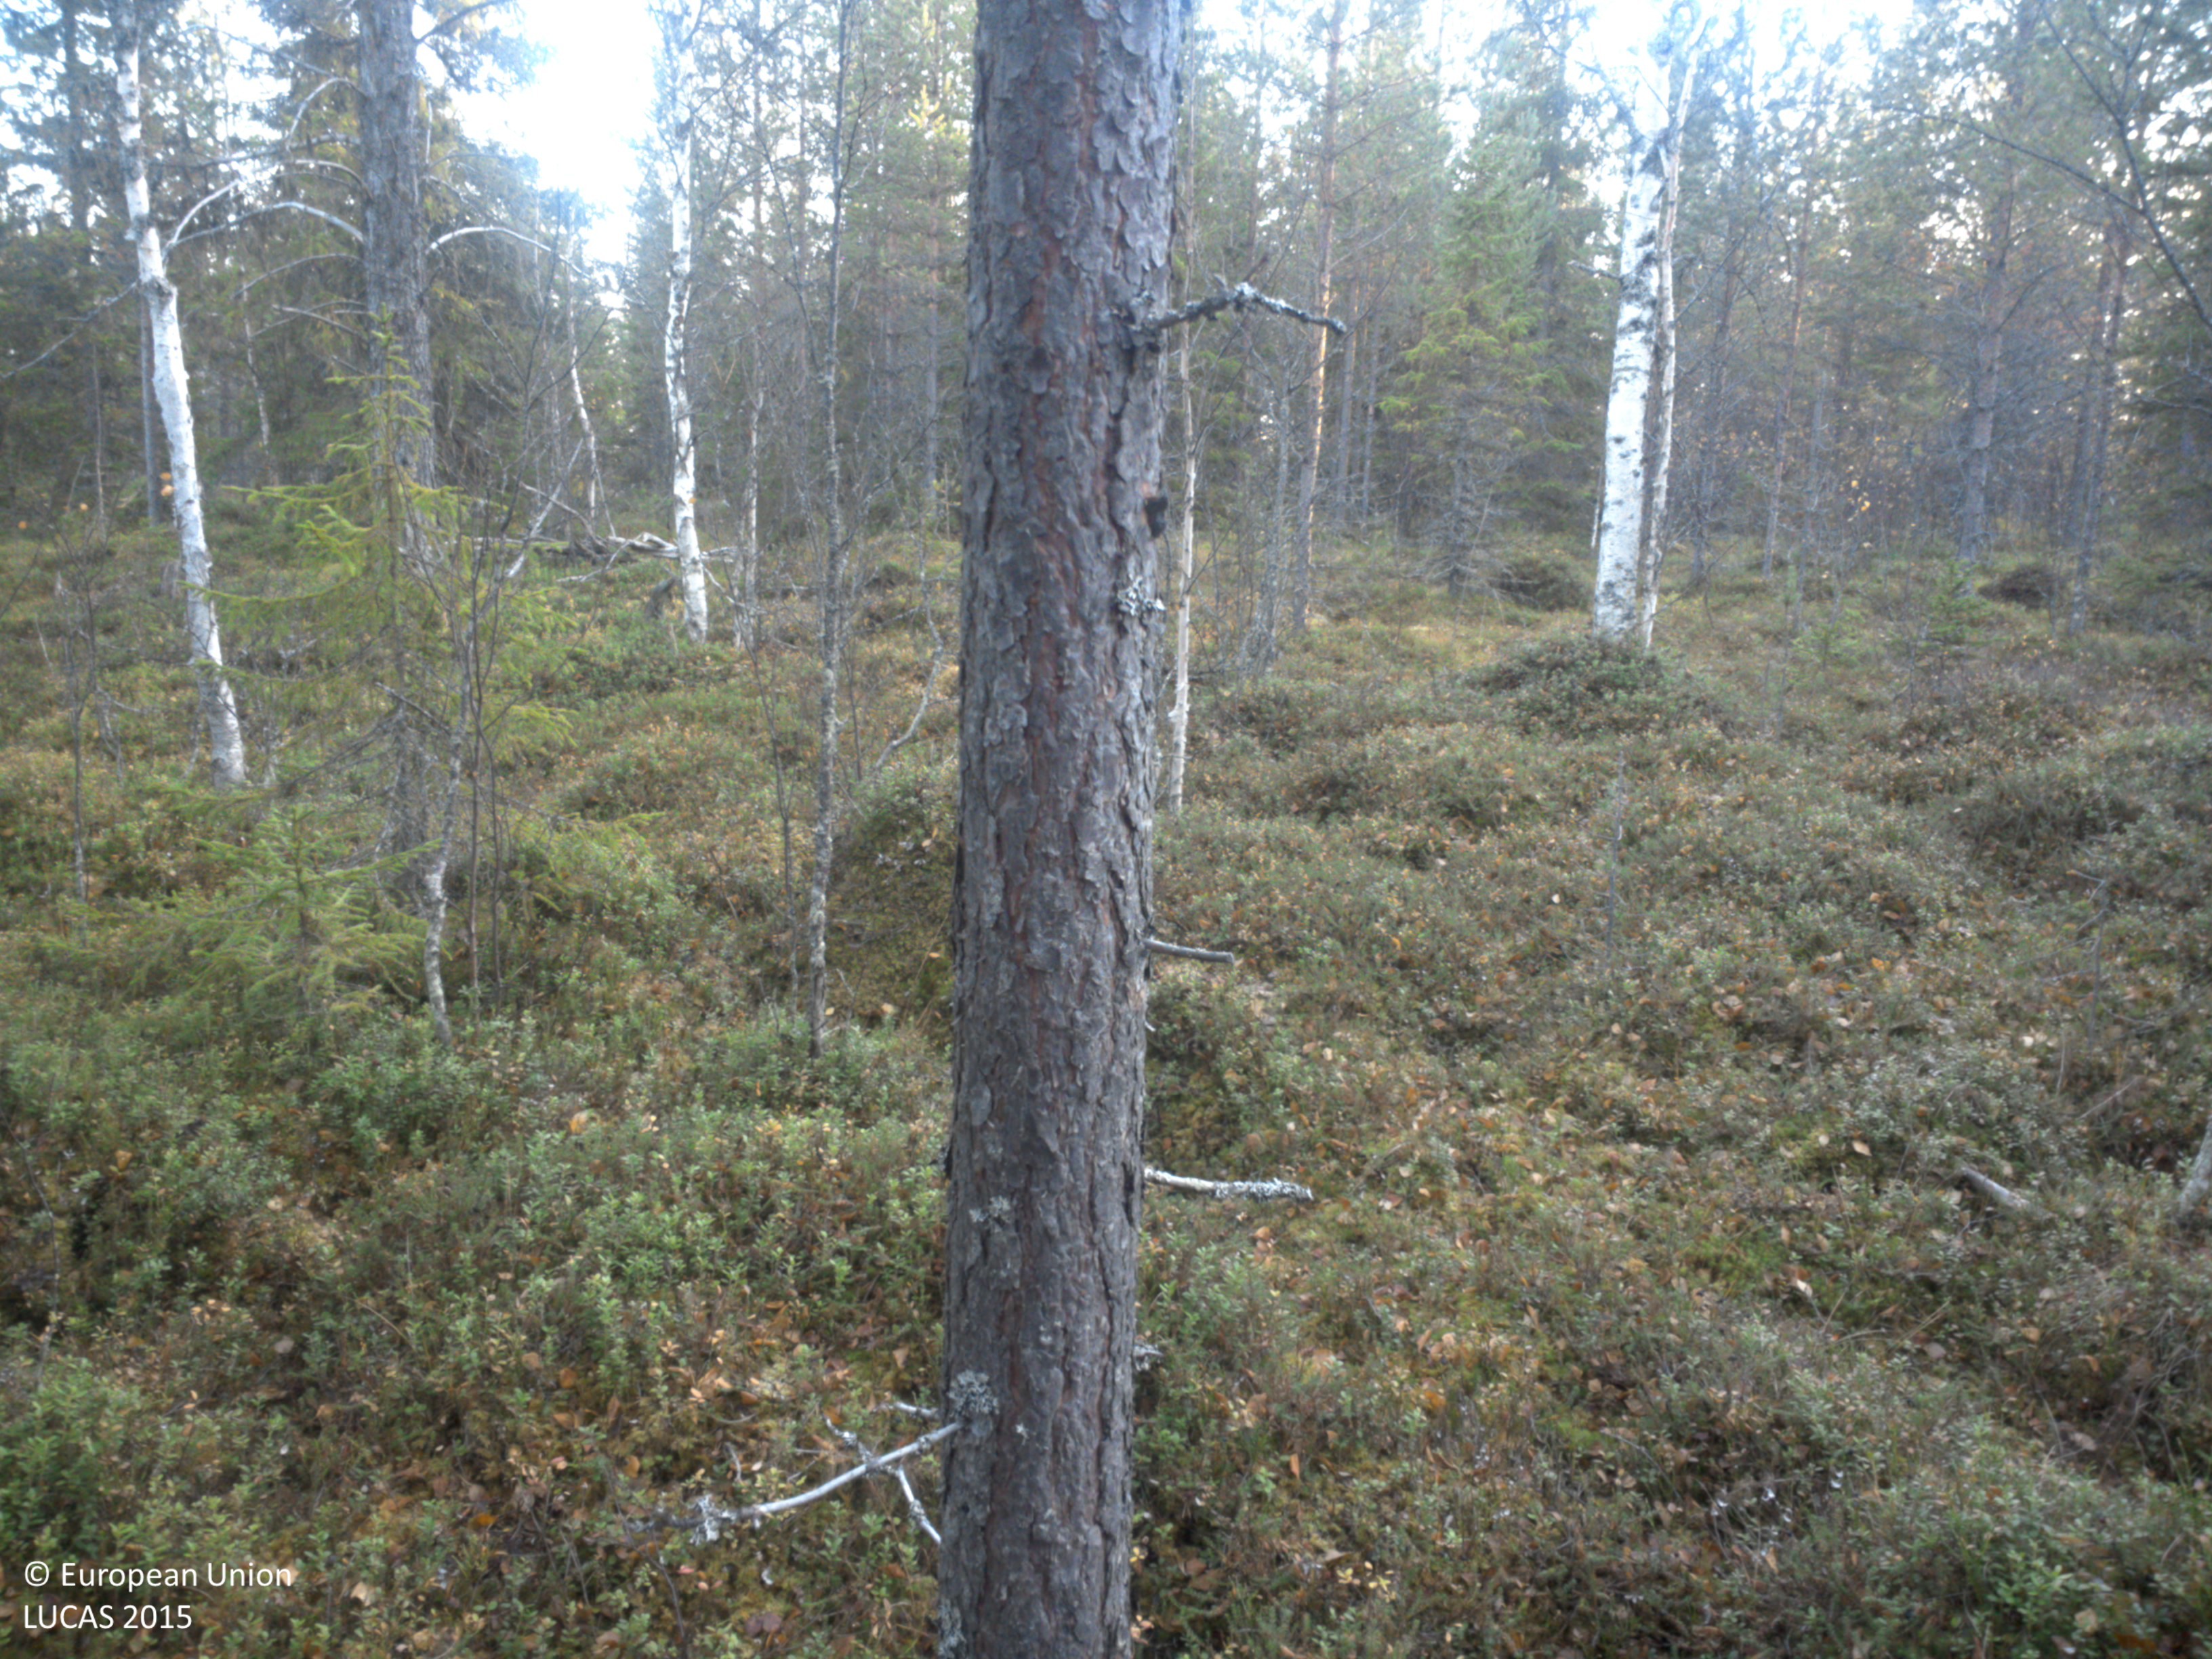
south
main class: Woodland
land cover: Spruce dominated mixed woodland
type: boreal forest
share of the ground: 50 - 75 %
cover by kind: coniferous forest trees 45 %, shrubs 40 %, broadleaved forest trees 15 %
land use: Forestry
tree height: > 5 m
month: October
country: SE
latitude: 64.8399
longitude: 18.2077
